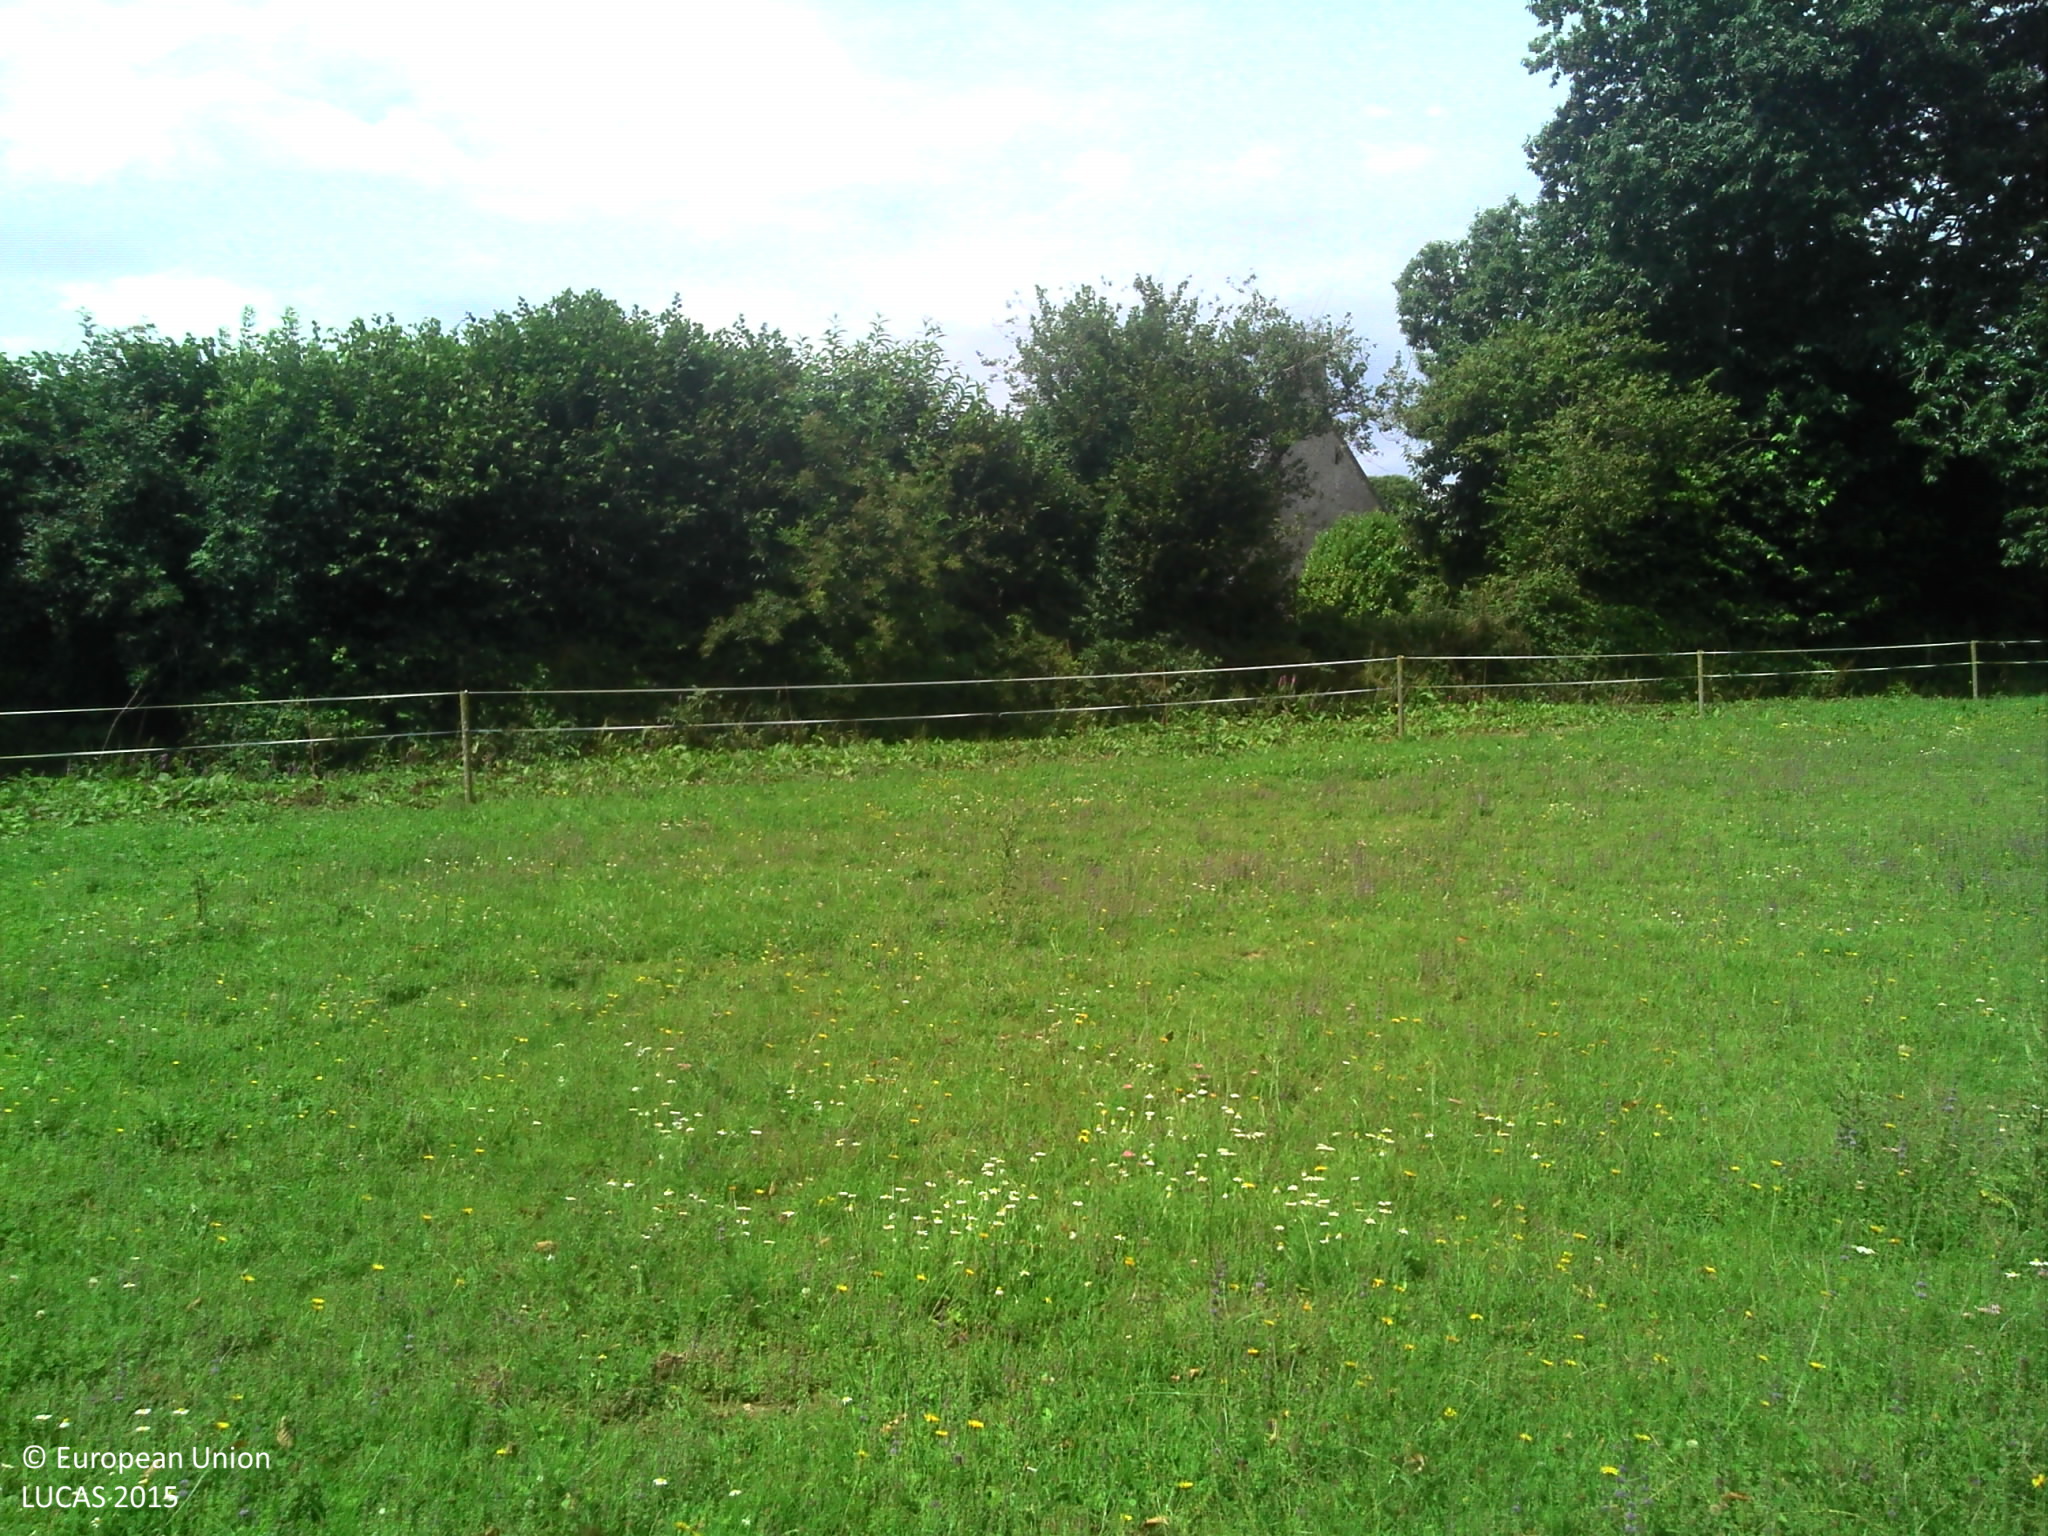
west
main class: Grassland
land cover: Grassland without tree/shrub cover
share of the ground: > 75 %
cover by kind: herbaceous plants 100 %
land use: Agriculture (excluding fallow land and kitchen gardens)
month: July
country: FR
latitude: 48.7794
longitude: -1.3548
